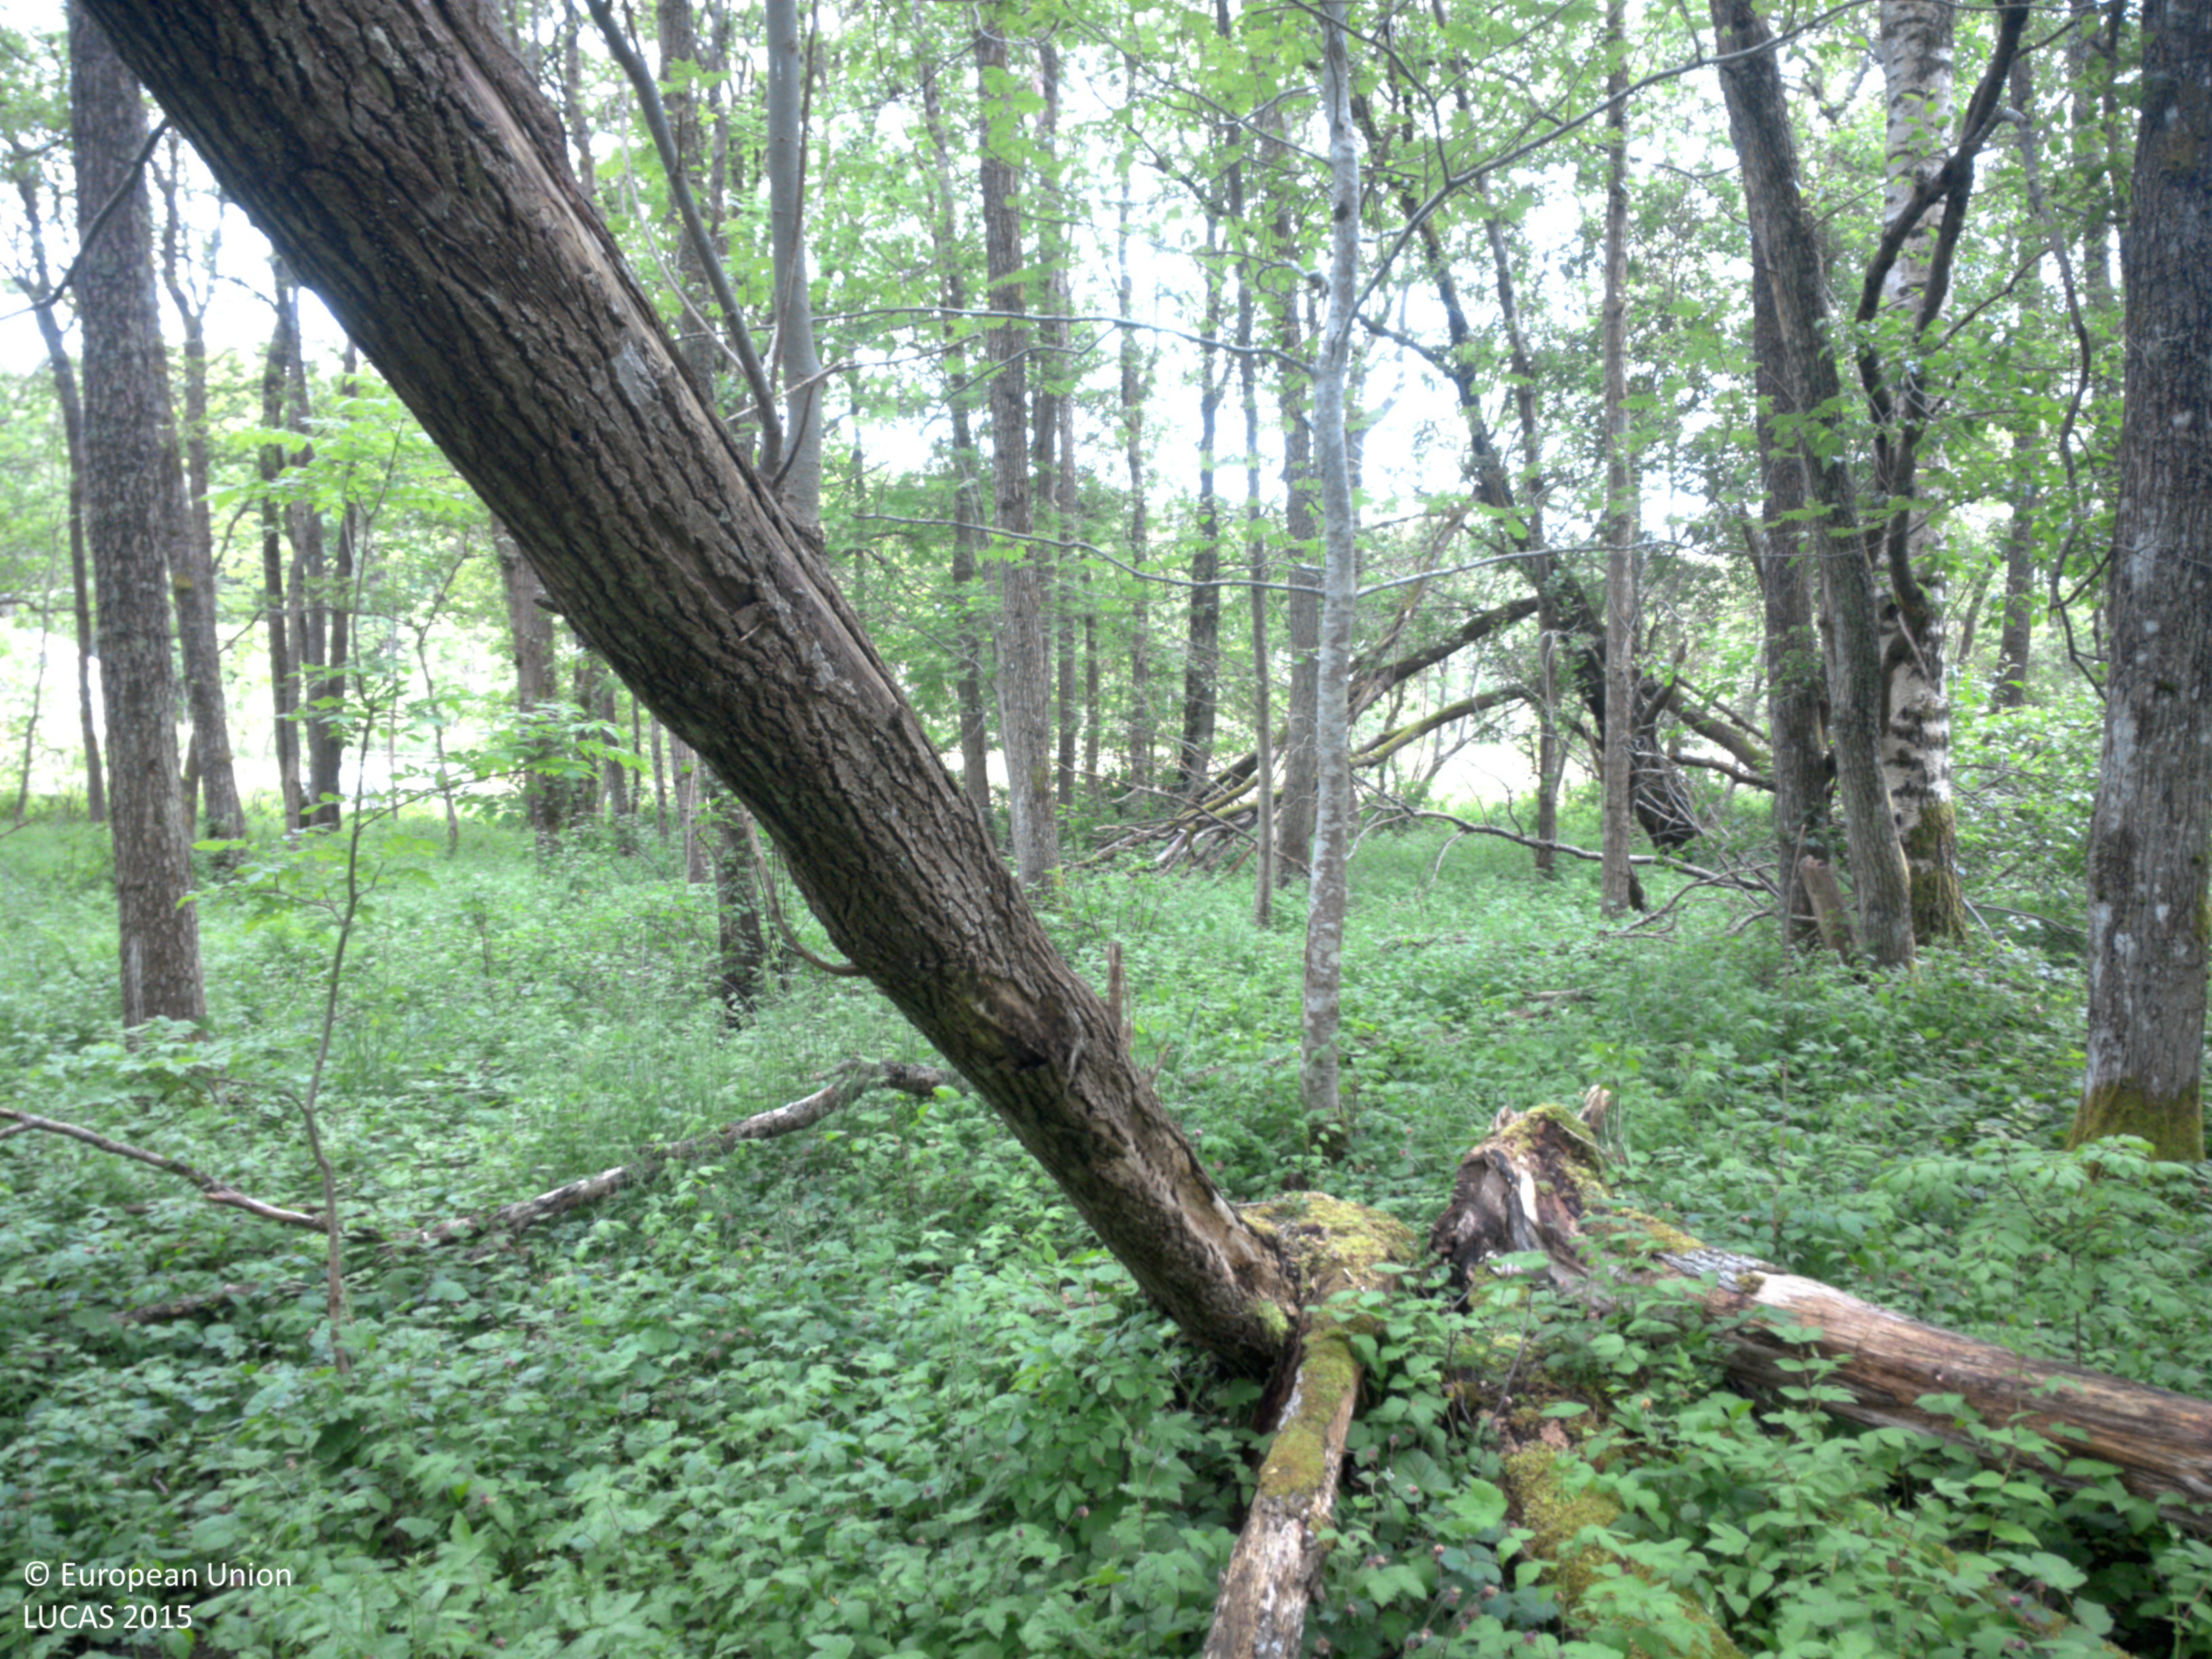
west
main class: Woodland
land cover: Broadleaved woodland
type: hemiboreal forest and nemoral coniferous forest and mixed broadleaved-coniferous forest
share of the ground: 50 - 75 %
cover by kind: broadleaved forest trees 75 %, herbaceous plants 25 %
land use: Agriculture (excluding fallow land and kitchen gardens)
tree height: > 5 m
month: June
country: SE
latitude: 58.3368
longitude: 11.5170
